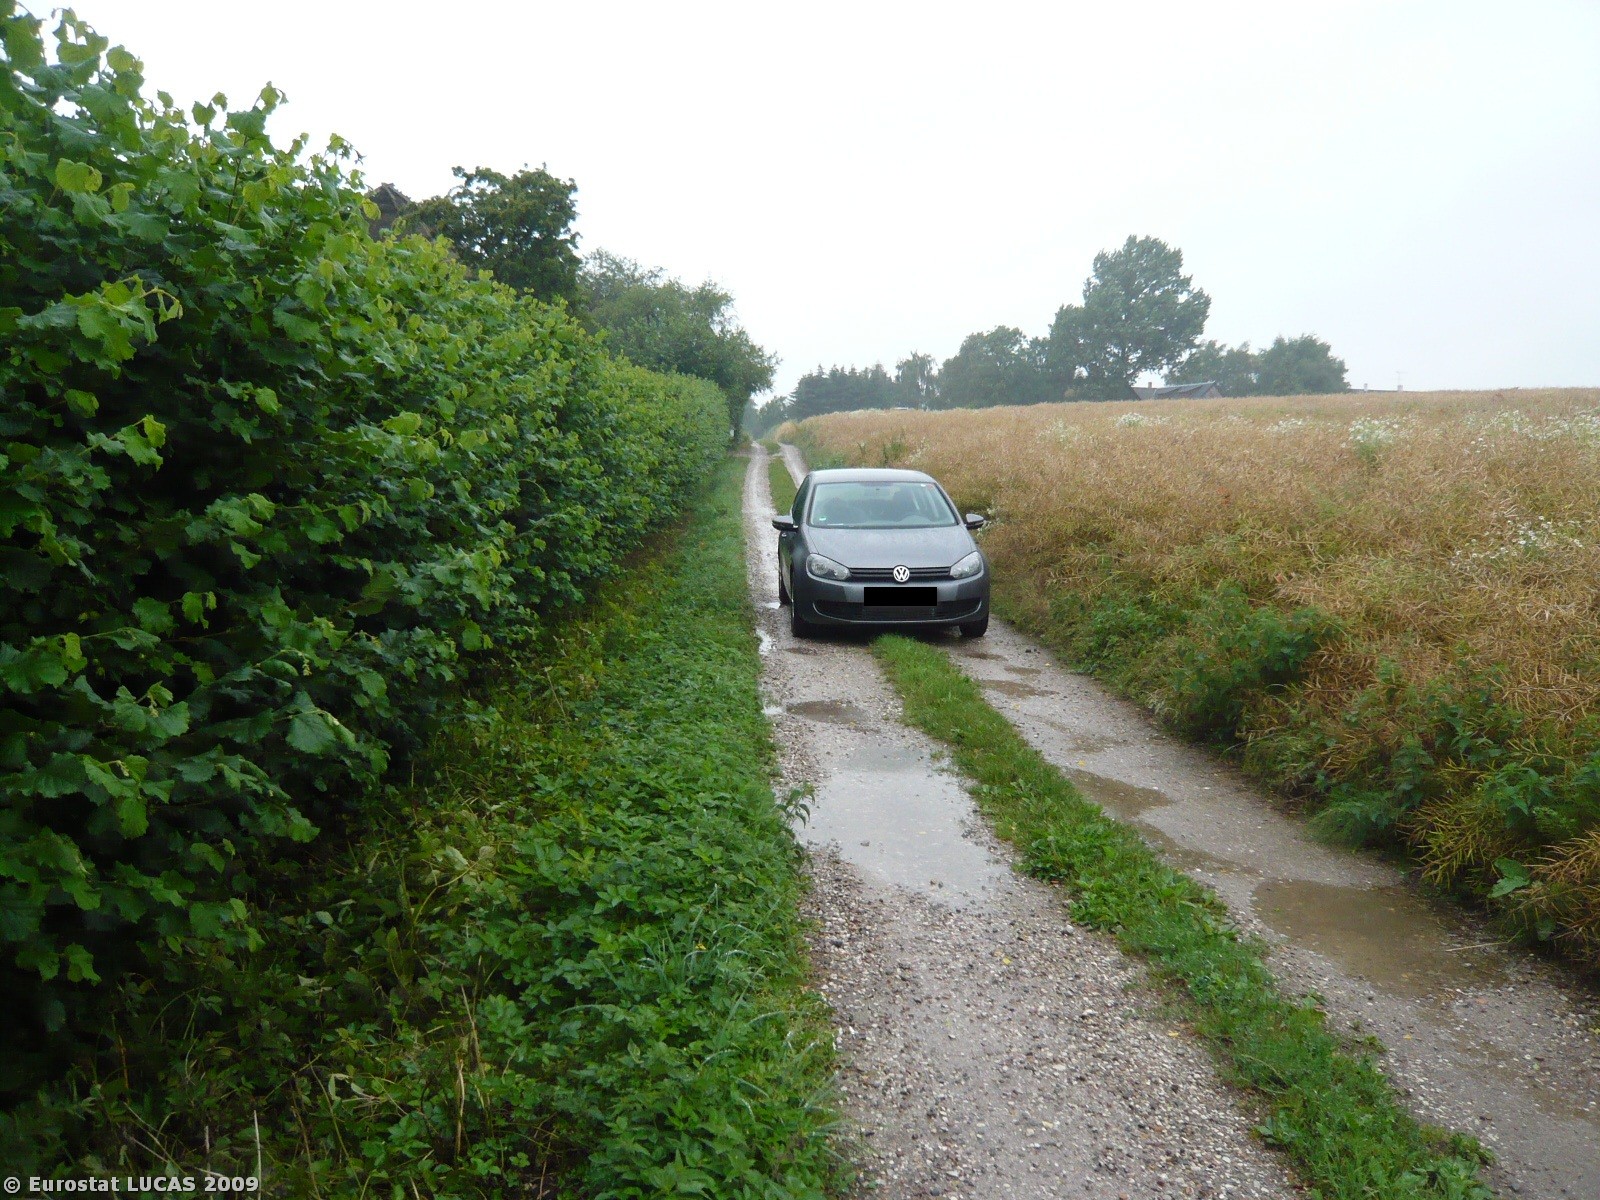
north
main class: Cropland
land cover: Rape and turnip rape
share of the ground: > 75 %
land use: Agriculture (excluding fallow land and kitchen gardens)
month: July
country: DK
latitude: 55.7787
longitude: 11.8637
